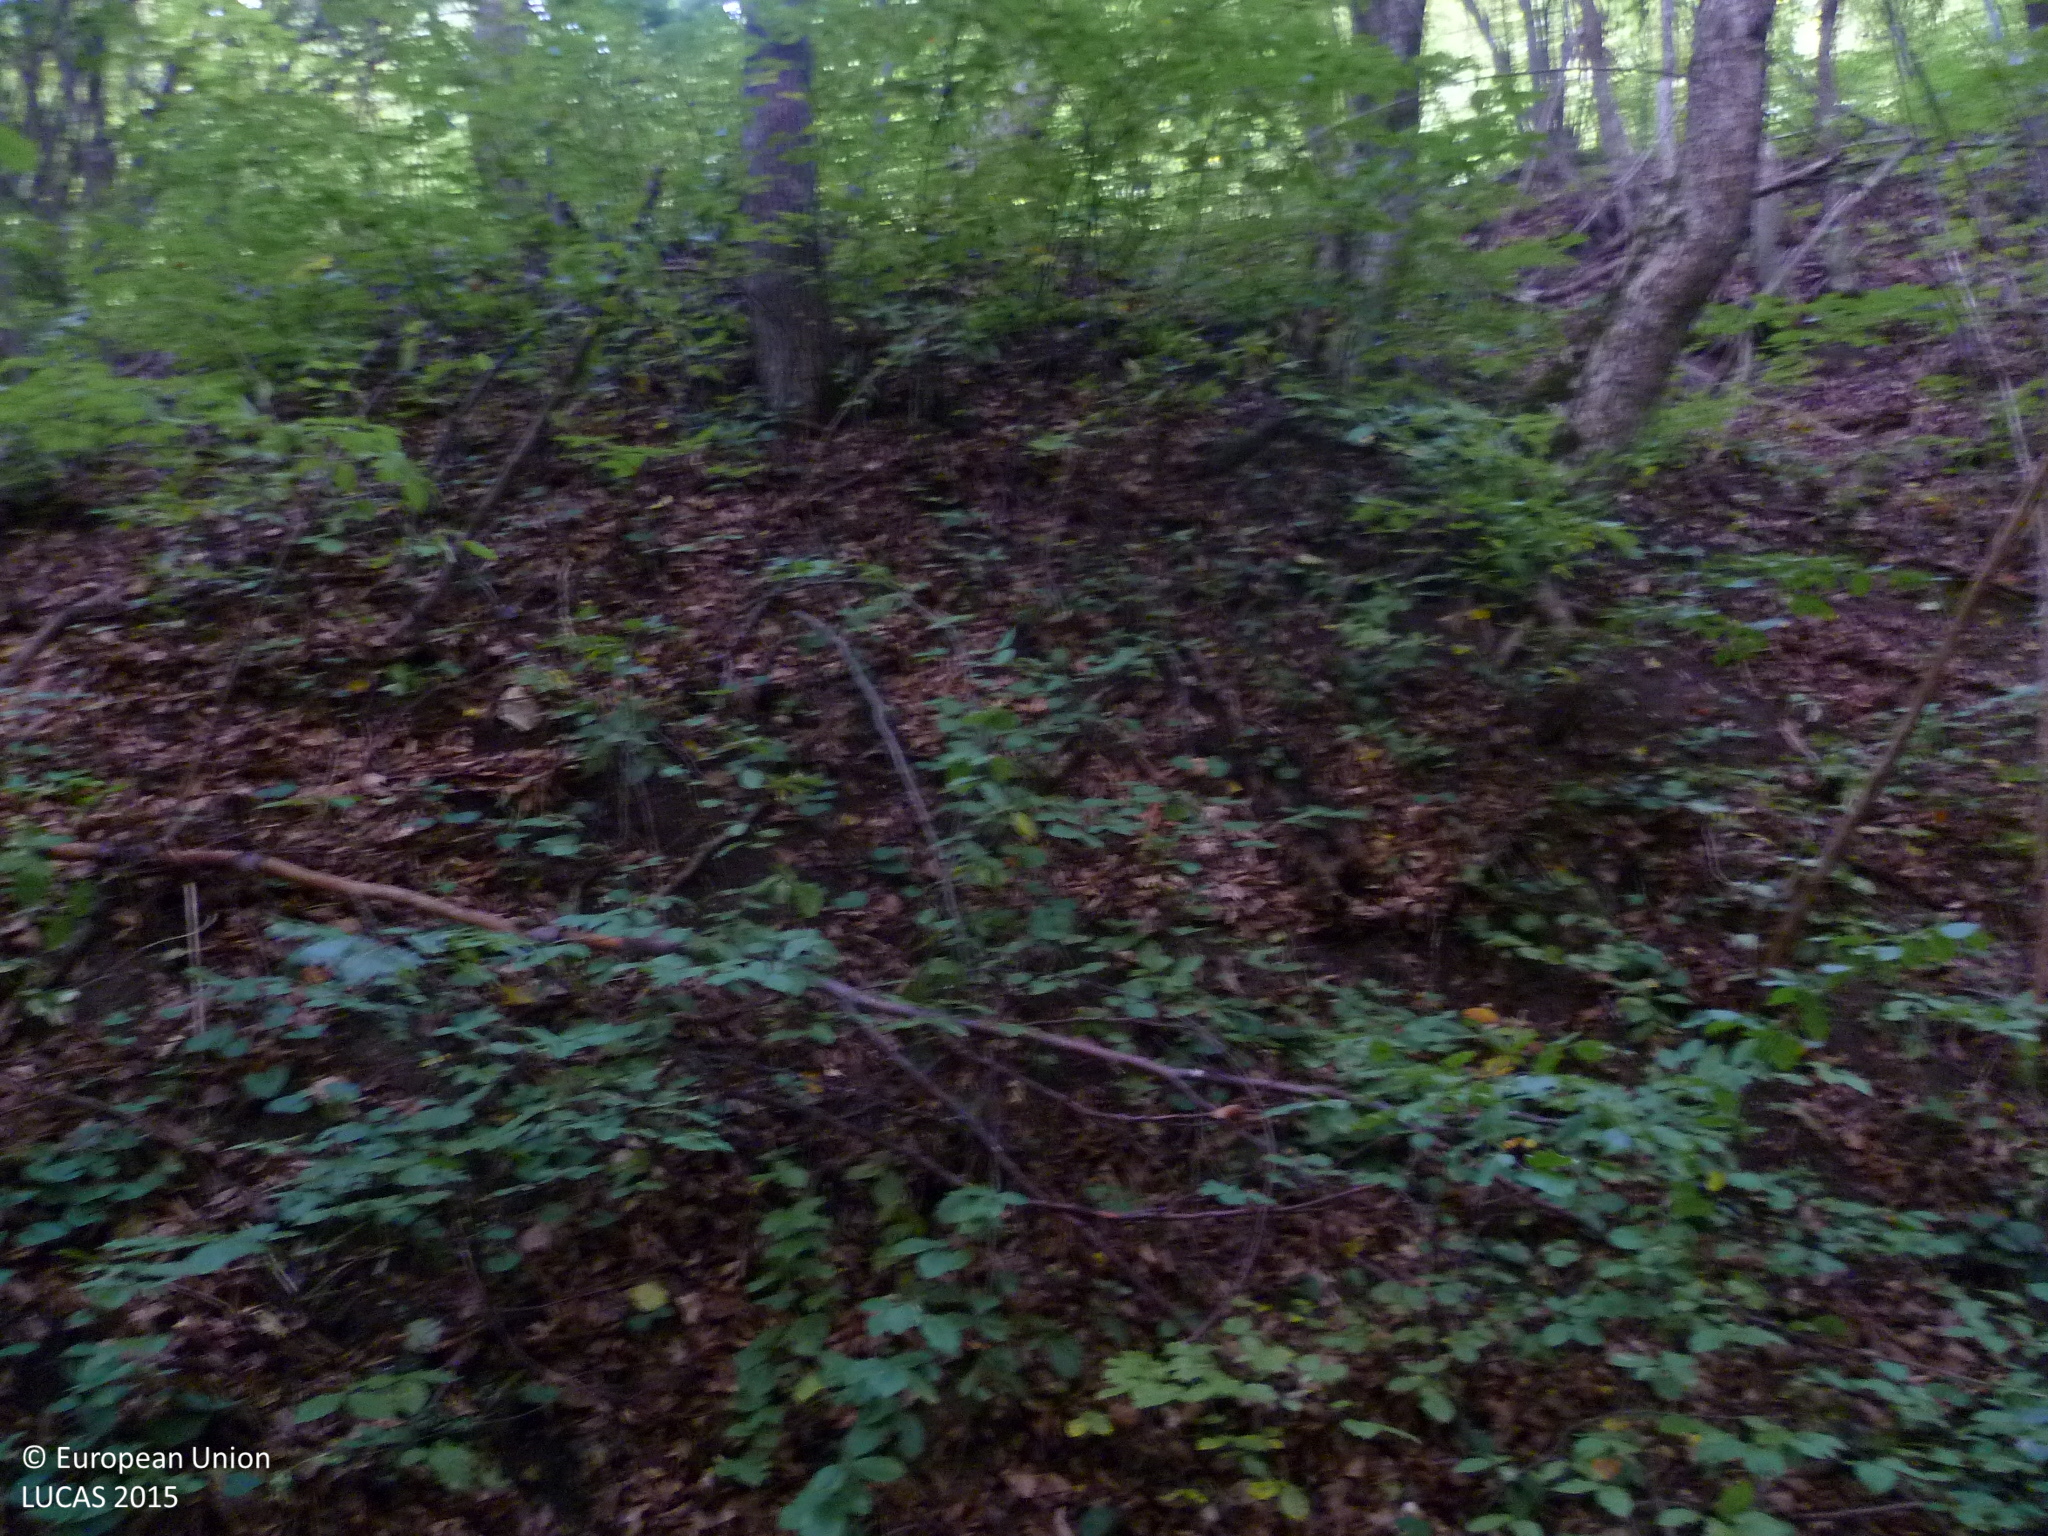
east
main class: Woodland
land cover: Broadleaved woodland
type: beech forest
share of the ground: 50 - 75 %
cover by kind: broadleaved forest trees 70 %, unconsolidated bare surface 20 %, lichens and mosses 10 %
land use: Forestry
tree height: > 5 m
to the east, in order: Broadleaved woodland; Rivers and streams; Broadleaved woodland; Grassland with sparse tree/shrub cover; Tracks; Grassland with sparse tree/shrub cover; Broadleaved woodland; Grassland with sparse tree/shrub cover; Tracks; Shrubland with sparse tree cover; Broadleaved woodland; Fences; Grassland with sparse tree/shrub cover
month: October
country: BG
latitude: 42.8559
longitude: 22.6937
